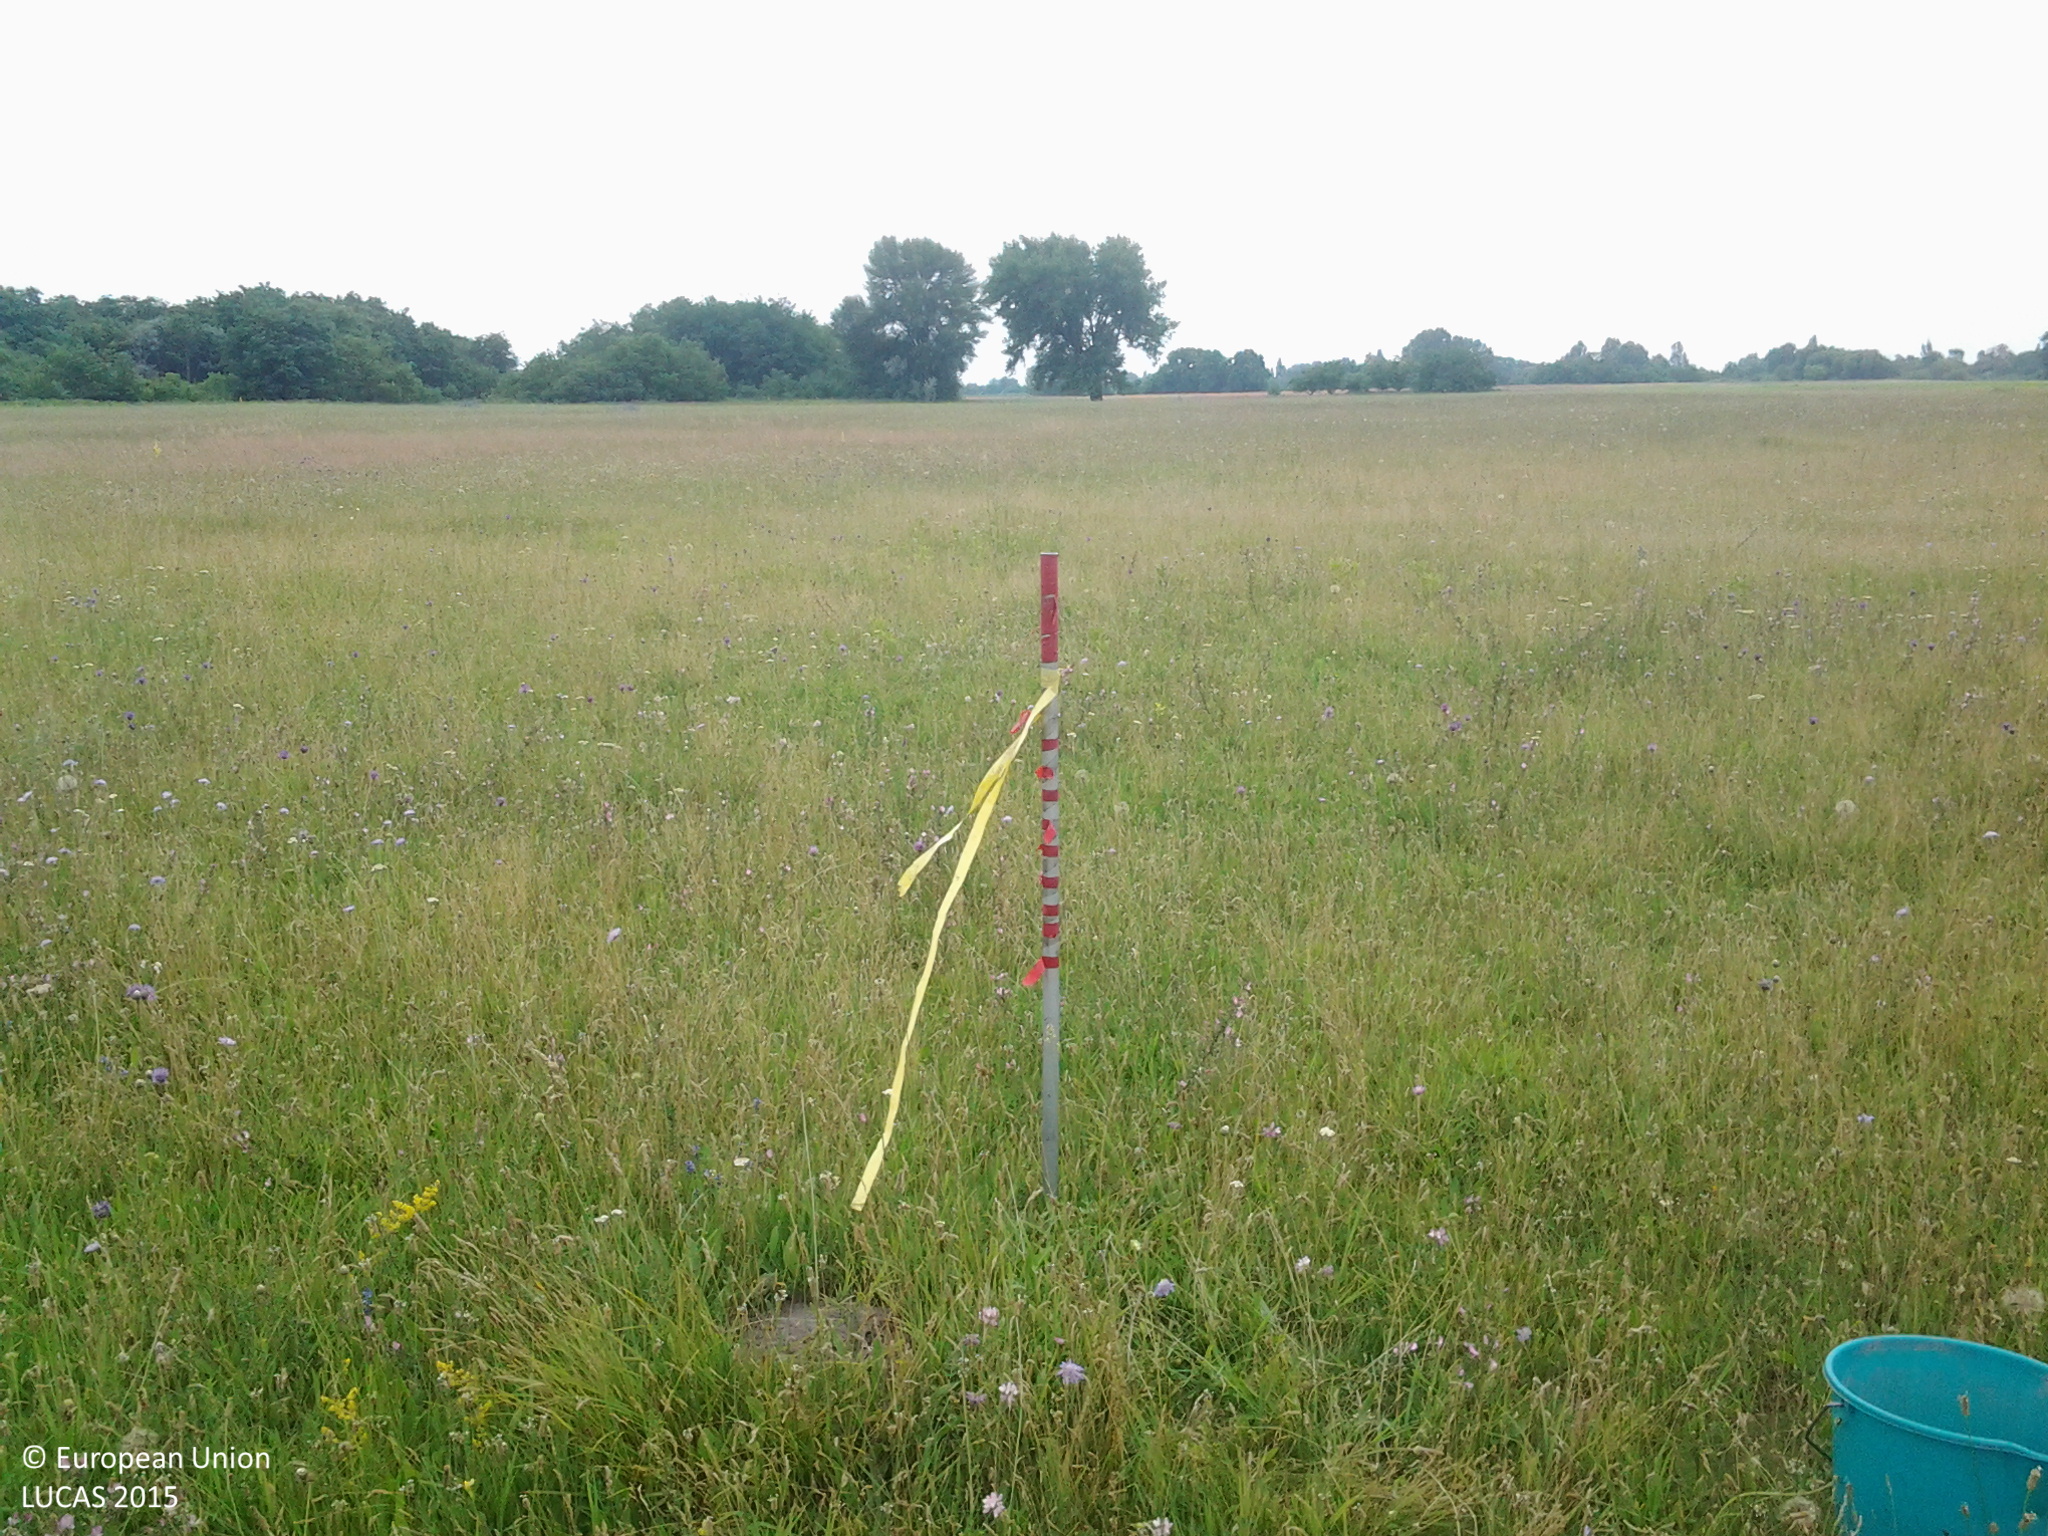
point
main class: Grassland
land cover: Spontaneously vegetated surfaces
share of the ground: > 75 %
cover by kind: herbaceous plants 100 %
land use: Semi-natural and natural areas not in use
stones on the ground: < 10 %
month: June
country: HU
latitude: 46.7988
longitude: 19.2801
